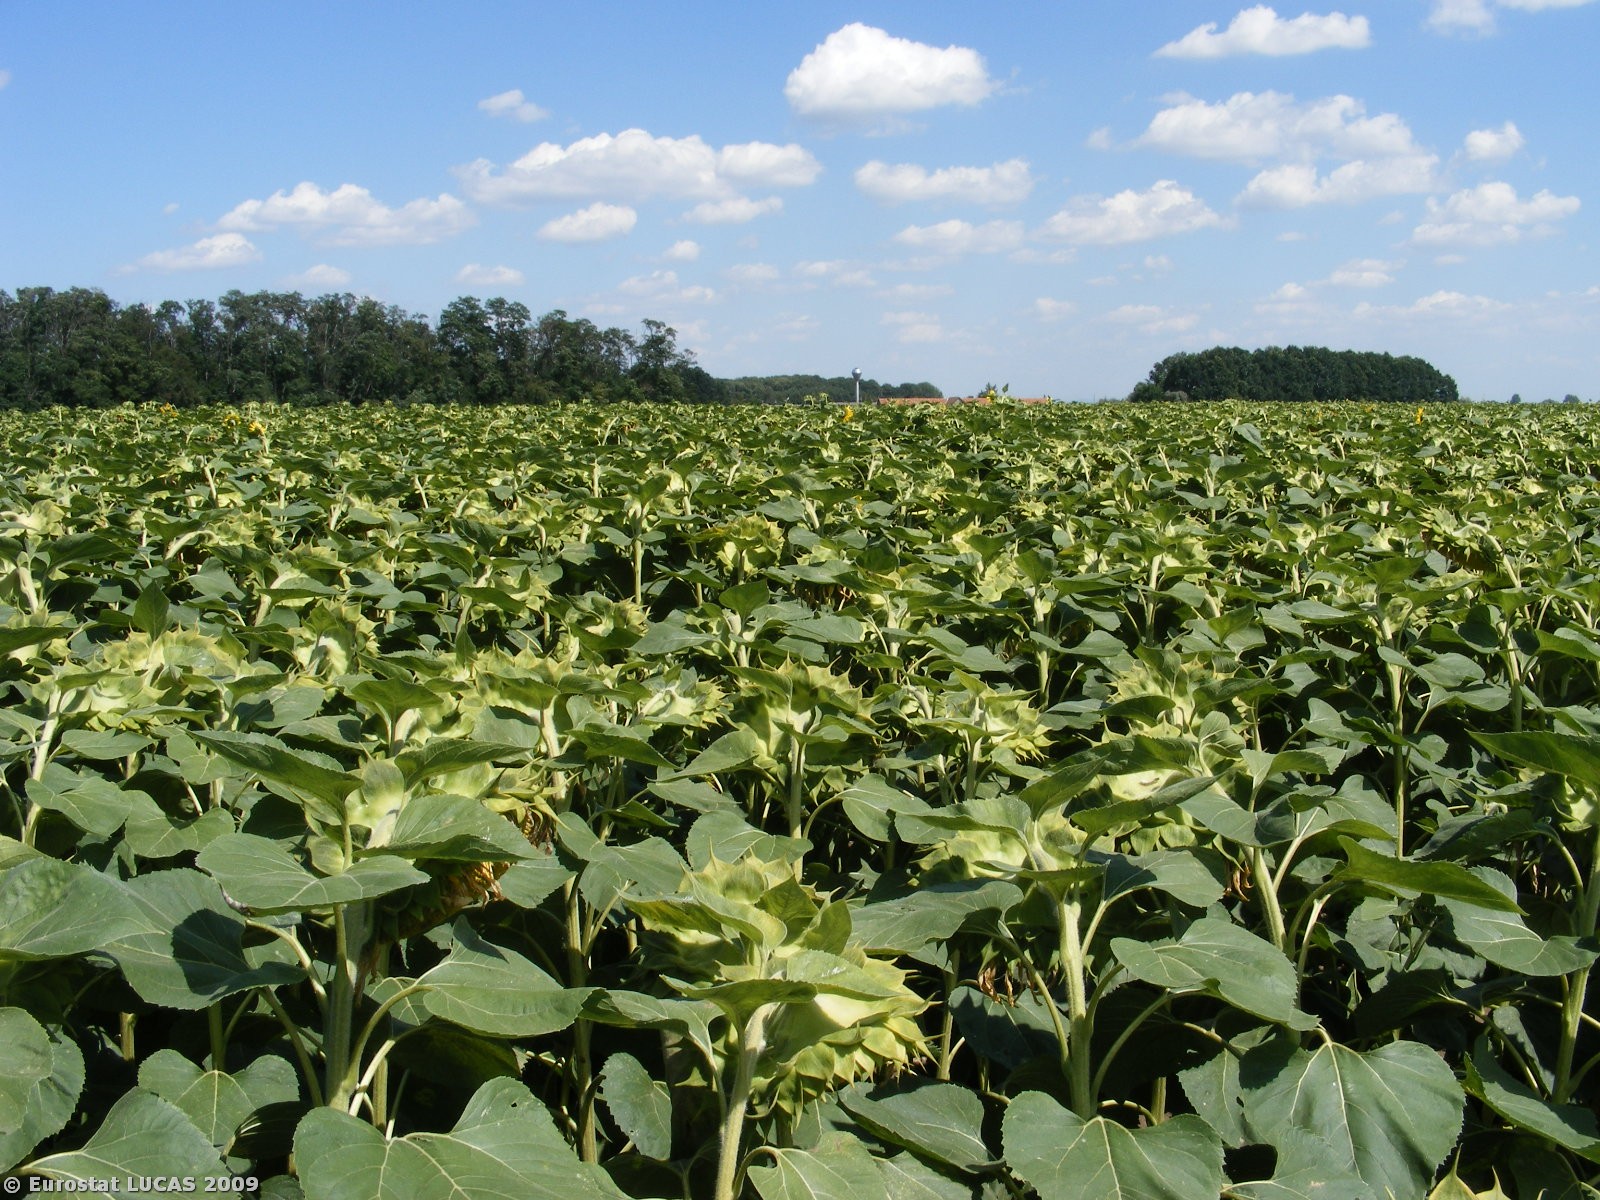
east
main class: Cropland
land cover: Sunflower
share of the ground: > 75 %
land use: Agriculture (excluding fallow land and kitchen gardens)
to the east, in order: Sunflower; Broadleaved woodland
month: July
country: HU
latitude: 47.3018
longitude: 21.7498
